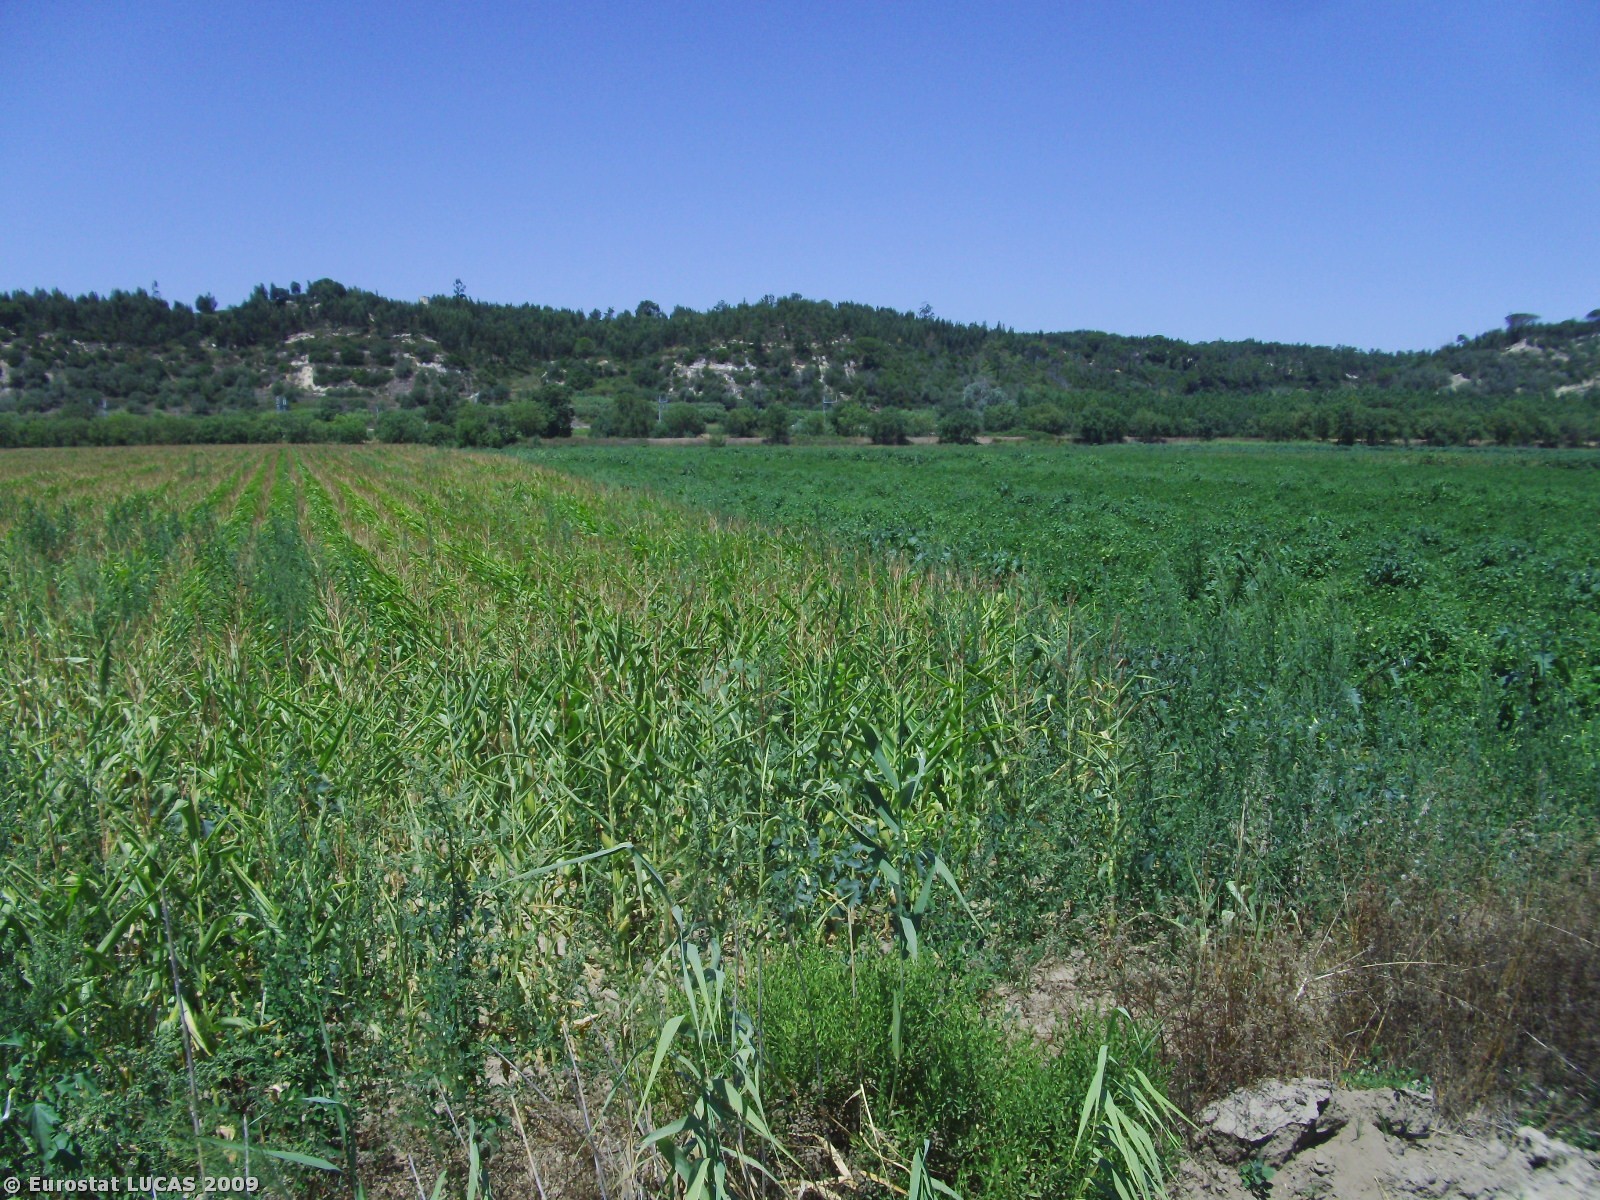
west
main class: Cropland
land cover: Tomatoes
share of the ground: > 75 %
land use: Agriculture (excluding fallow land and kitchen gardens)
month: July
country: PT
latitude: 39.1651
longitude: -8.7410
